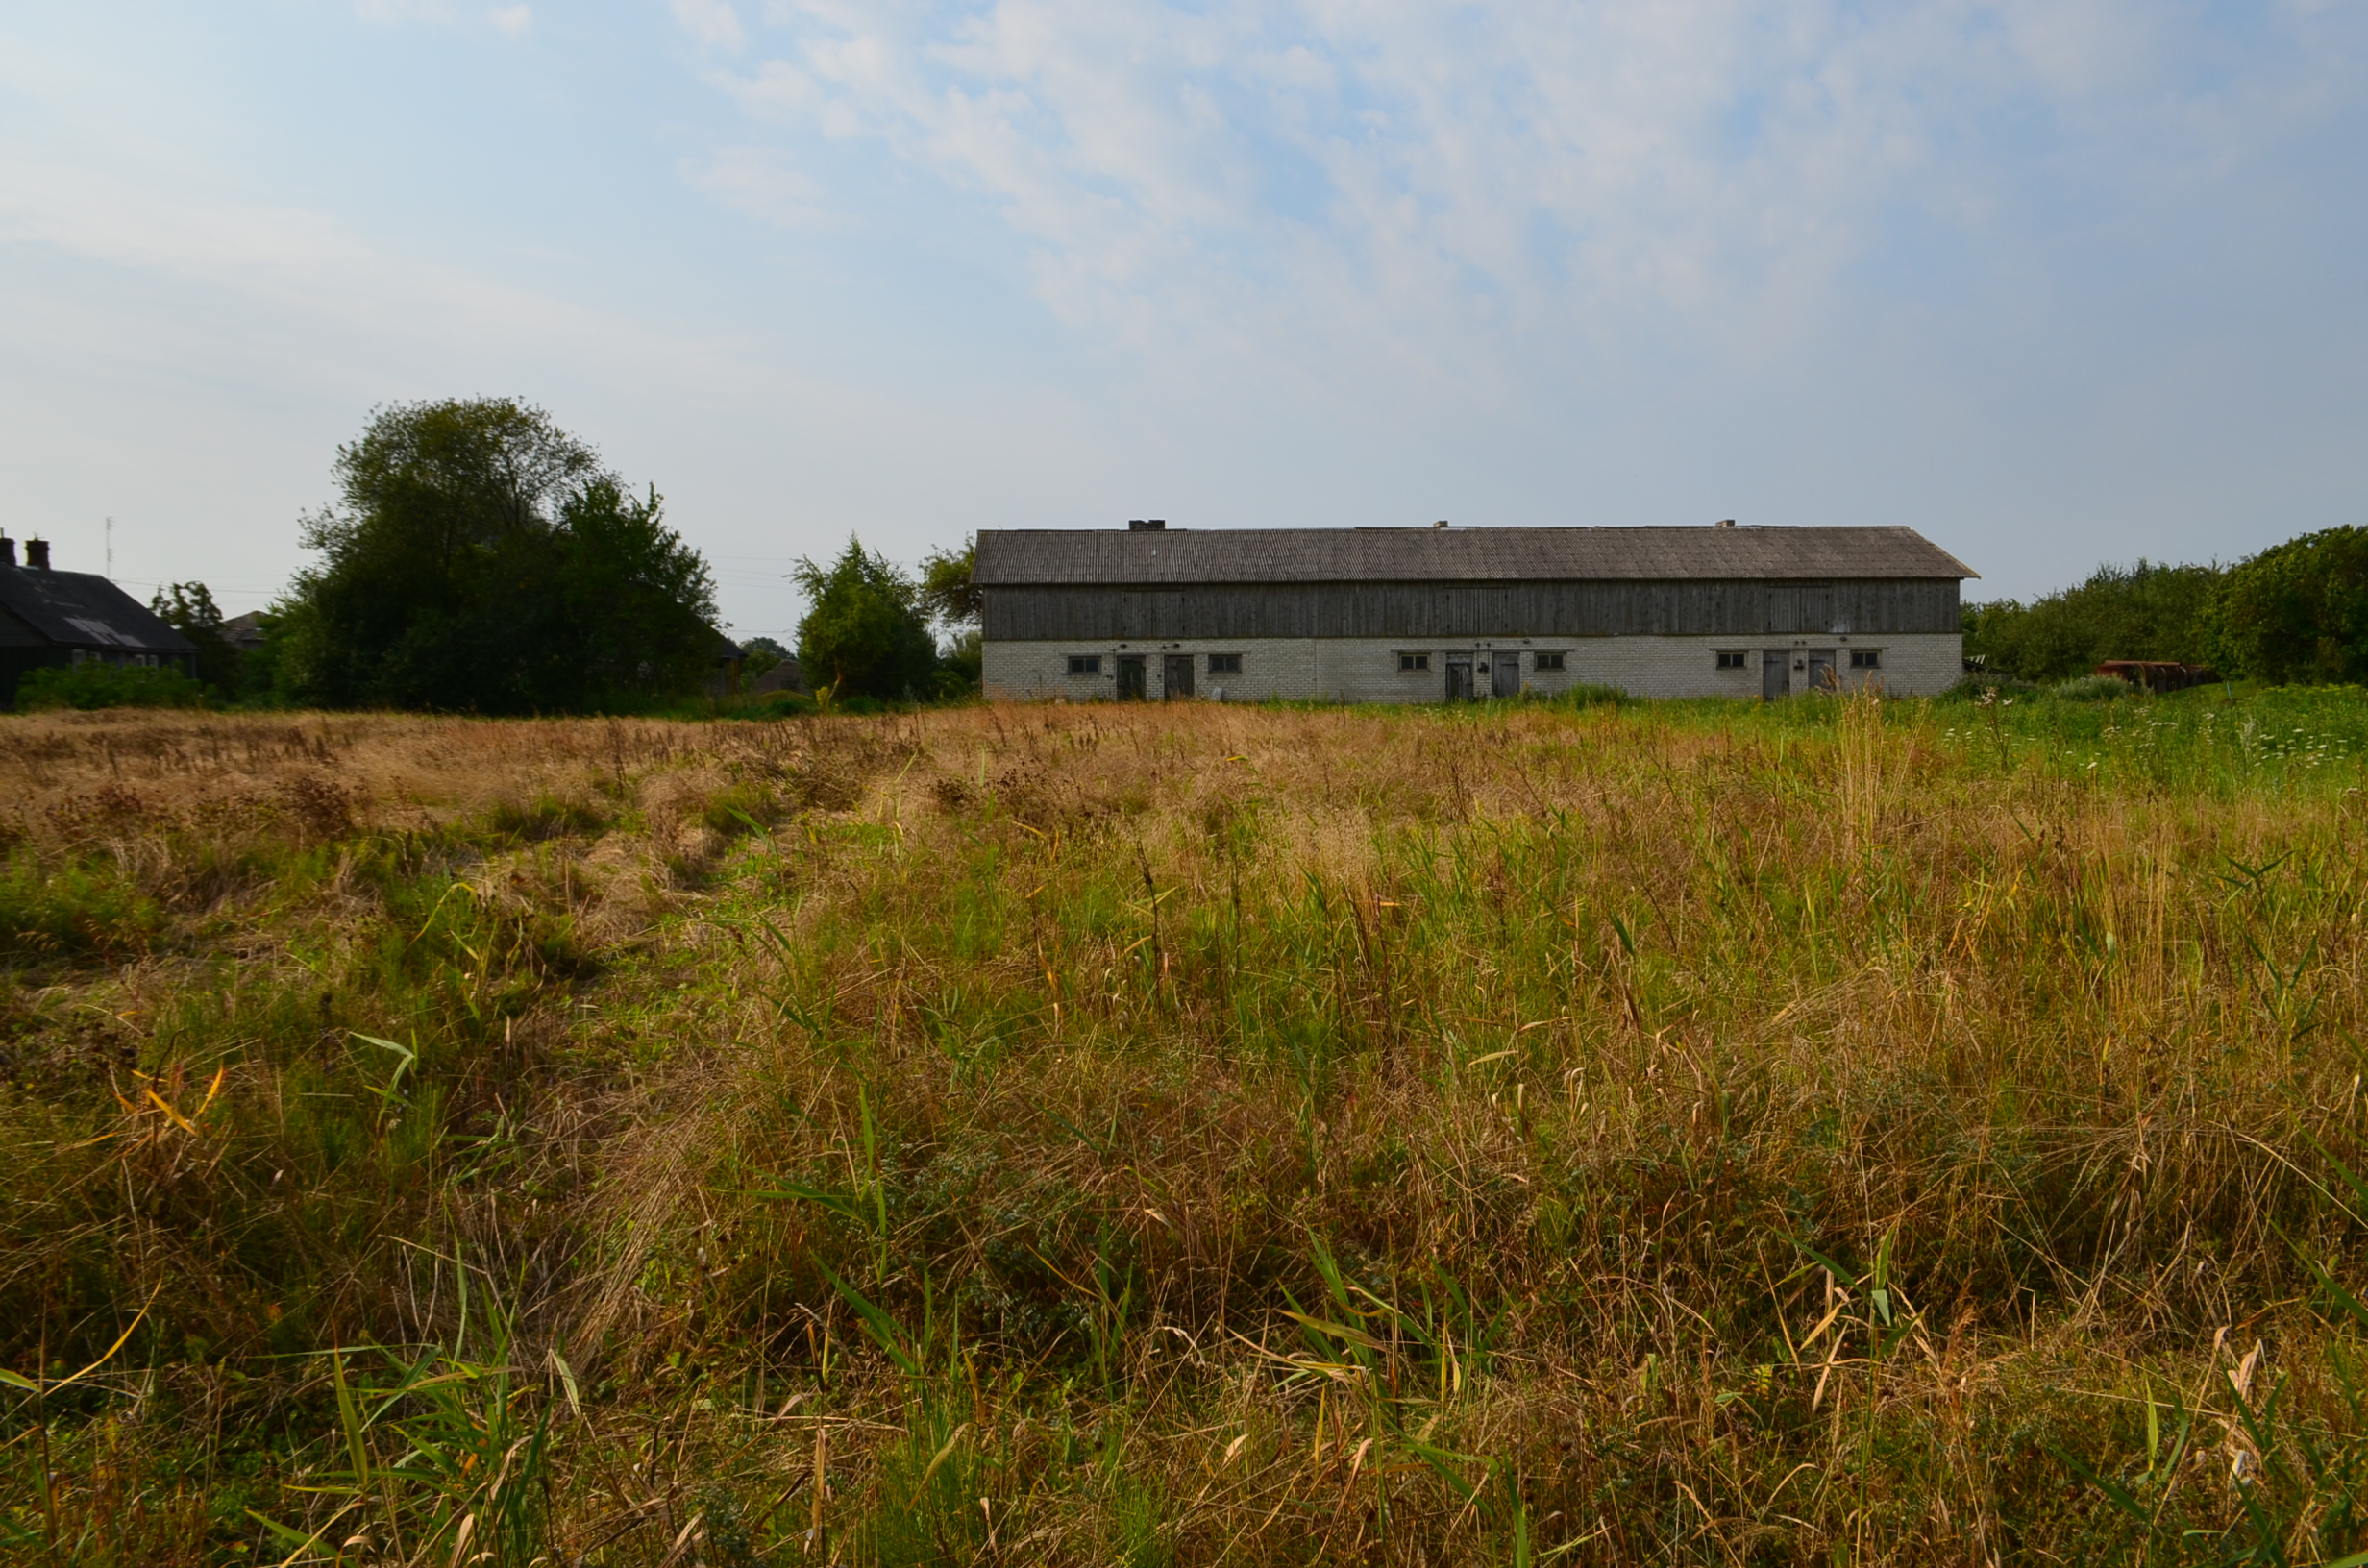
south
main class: Grassland
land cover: Spontaneously vegetated surfaces
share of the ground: > 75 %
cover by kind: herbaceous plants 95 %, shrubs 5 %
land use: Semi-natural and natural areas not in use
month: August
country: LV
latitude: 57.3492
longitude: 21.6236
